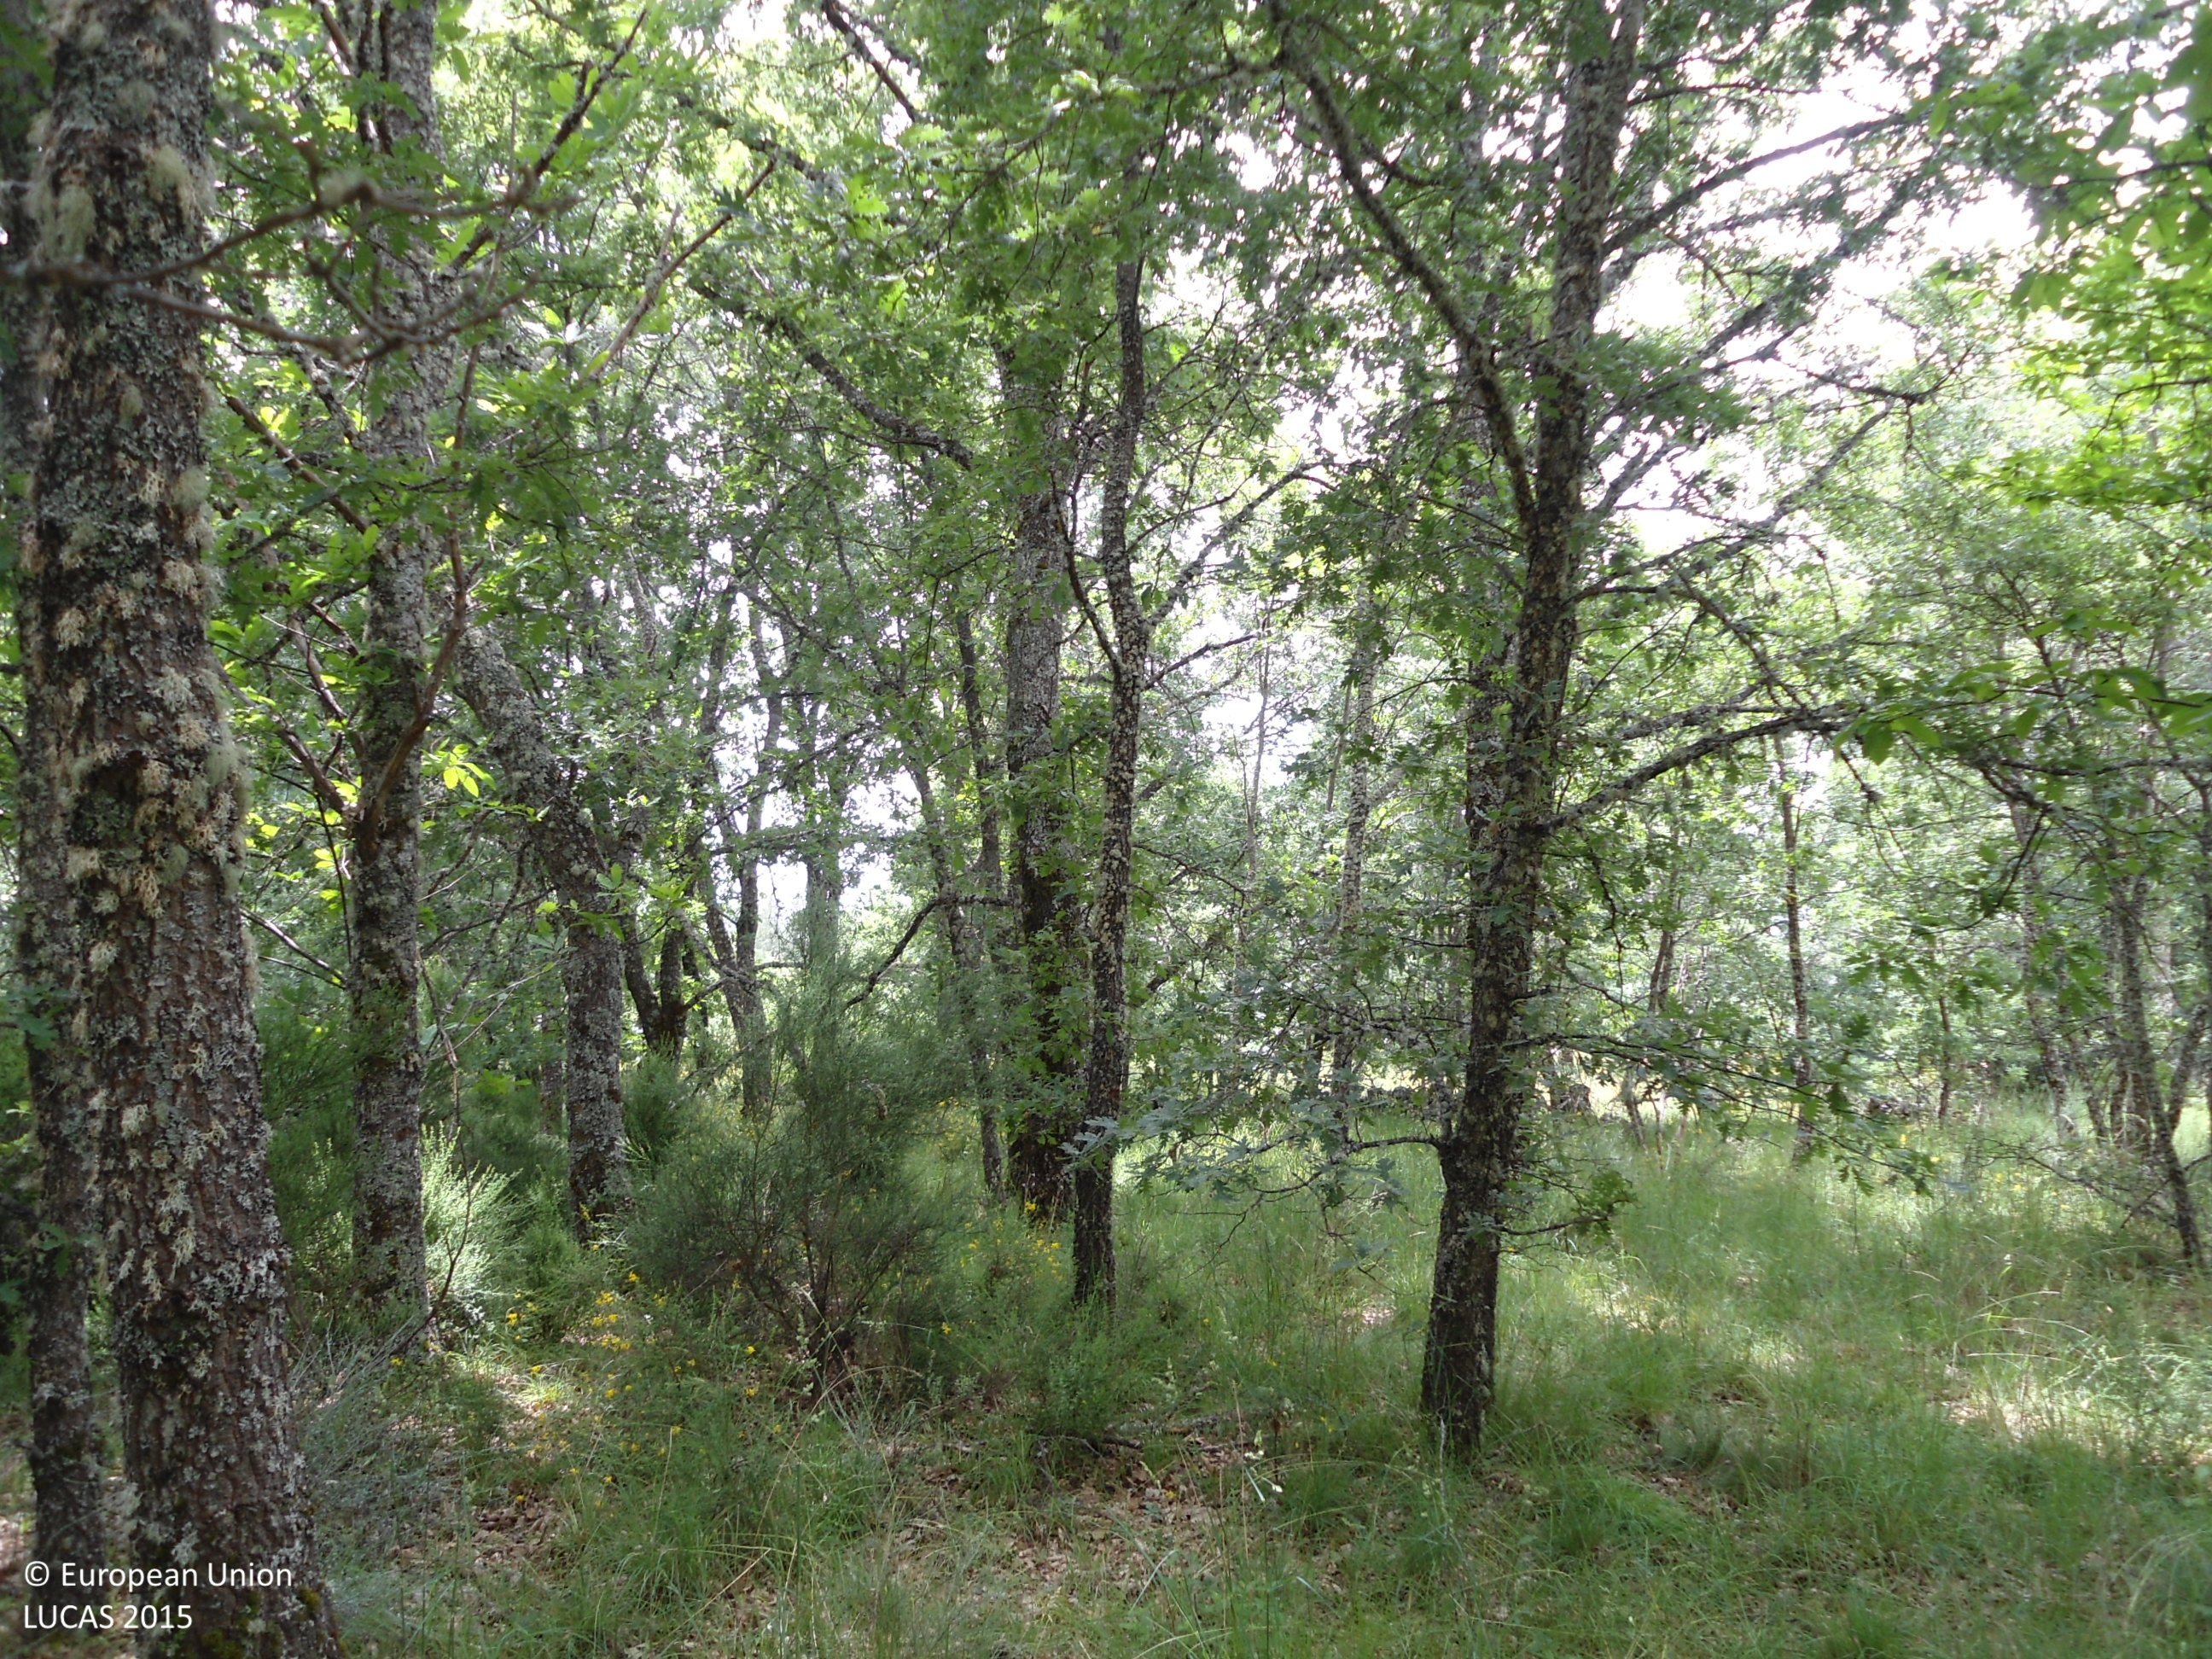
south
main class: Woodland
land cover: Broadleaved woodland
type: thermophilous deciduous forest
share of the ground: > 75 %
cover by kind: broadleaved forest trees 100 %
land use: Forestry
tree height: > 5 m
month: June
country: ES
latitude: 42.0842
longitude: -6.5901
